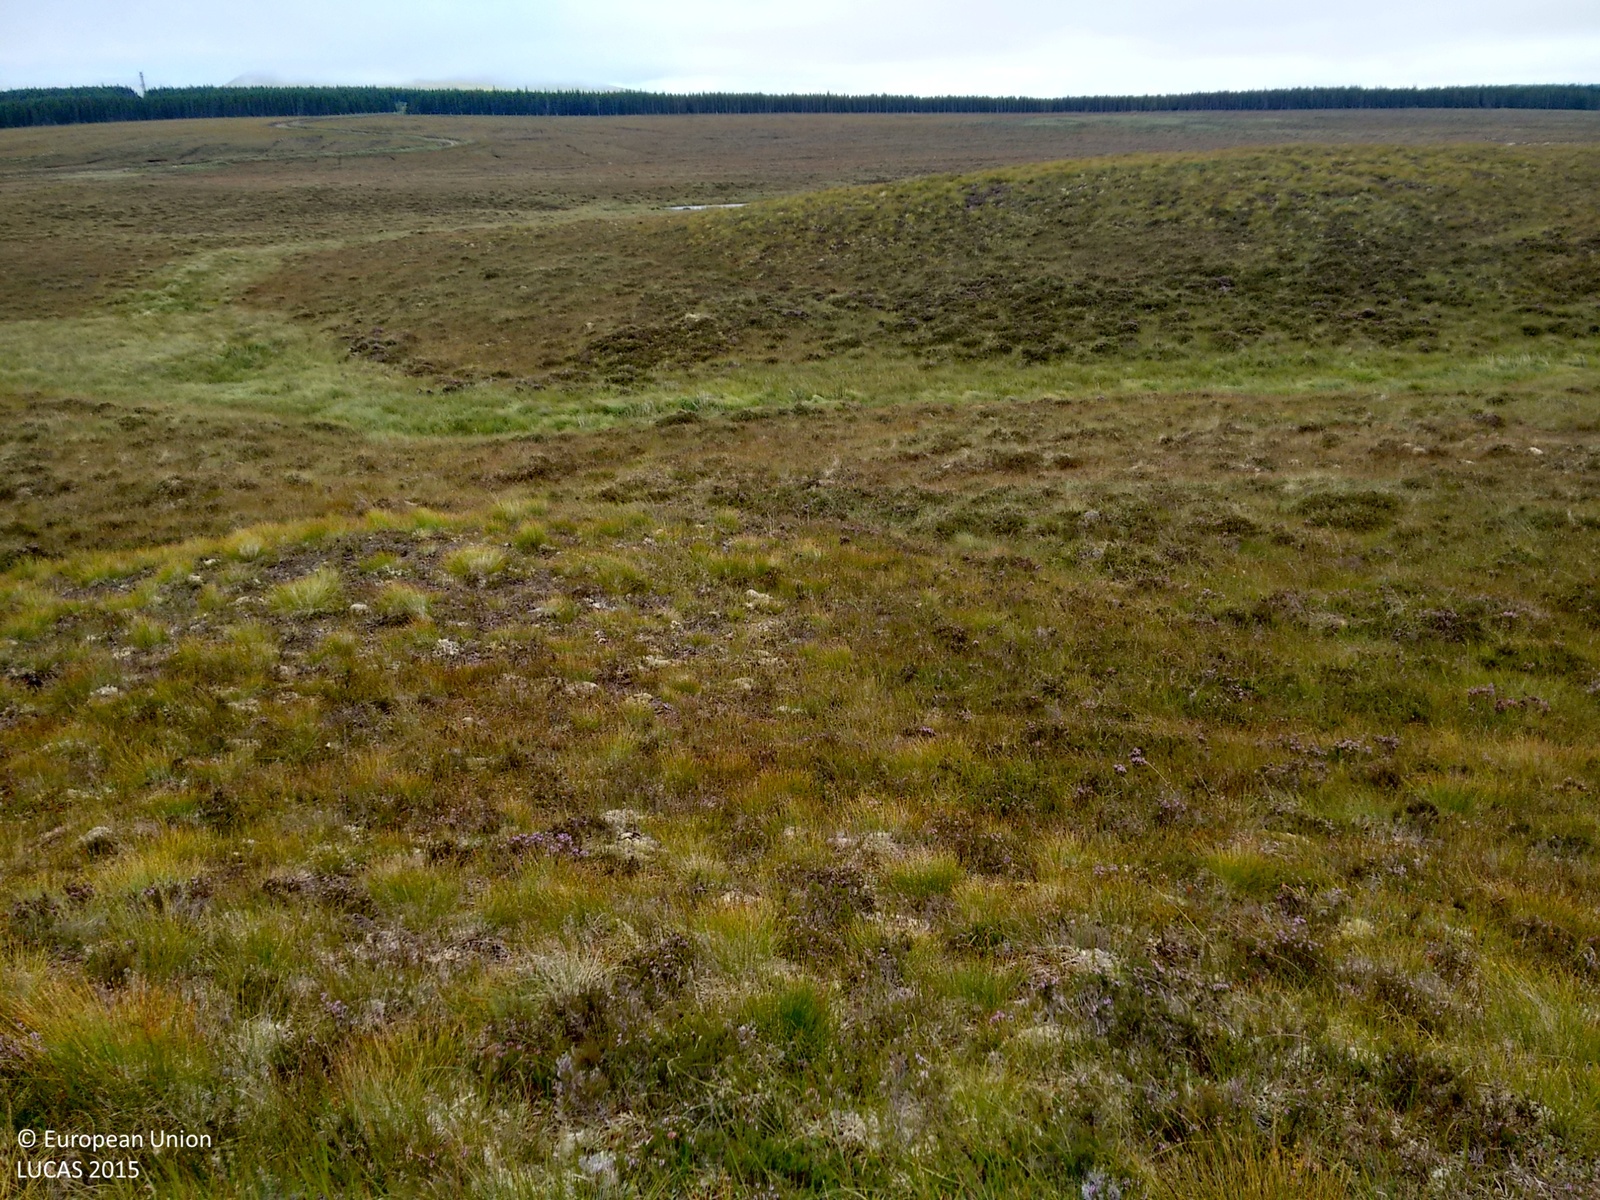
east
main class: Shrubland
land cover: Shrubland without tree cover
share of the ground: 50 - 75 %
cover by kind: shrubs 60 %, herbaceous plants 40 %
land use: Semi-natural and natural areas not in use
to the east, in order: Shrubland without tree cover; Rivers and streams; Shrubland without tree cover; Inland fresh water bodies; Shrubland without tree cover
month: September
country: GB
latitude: 58.1935
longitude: -4.5301
